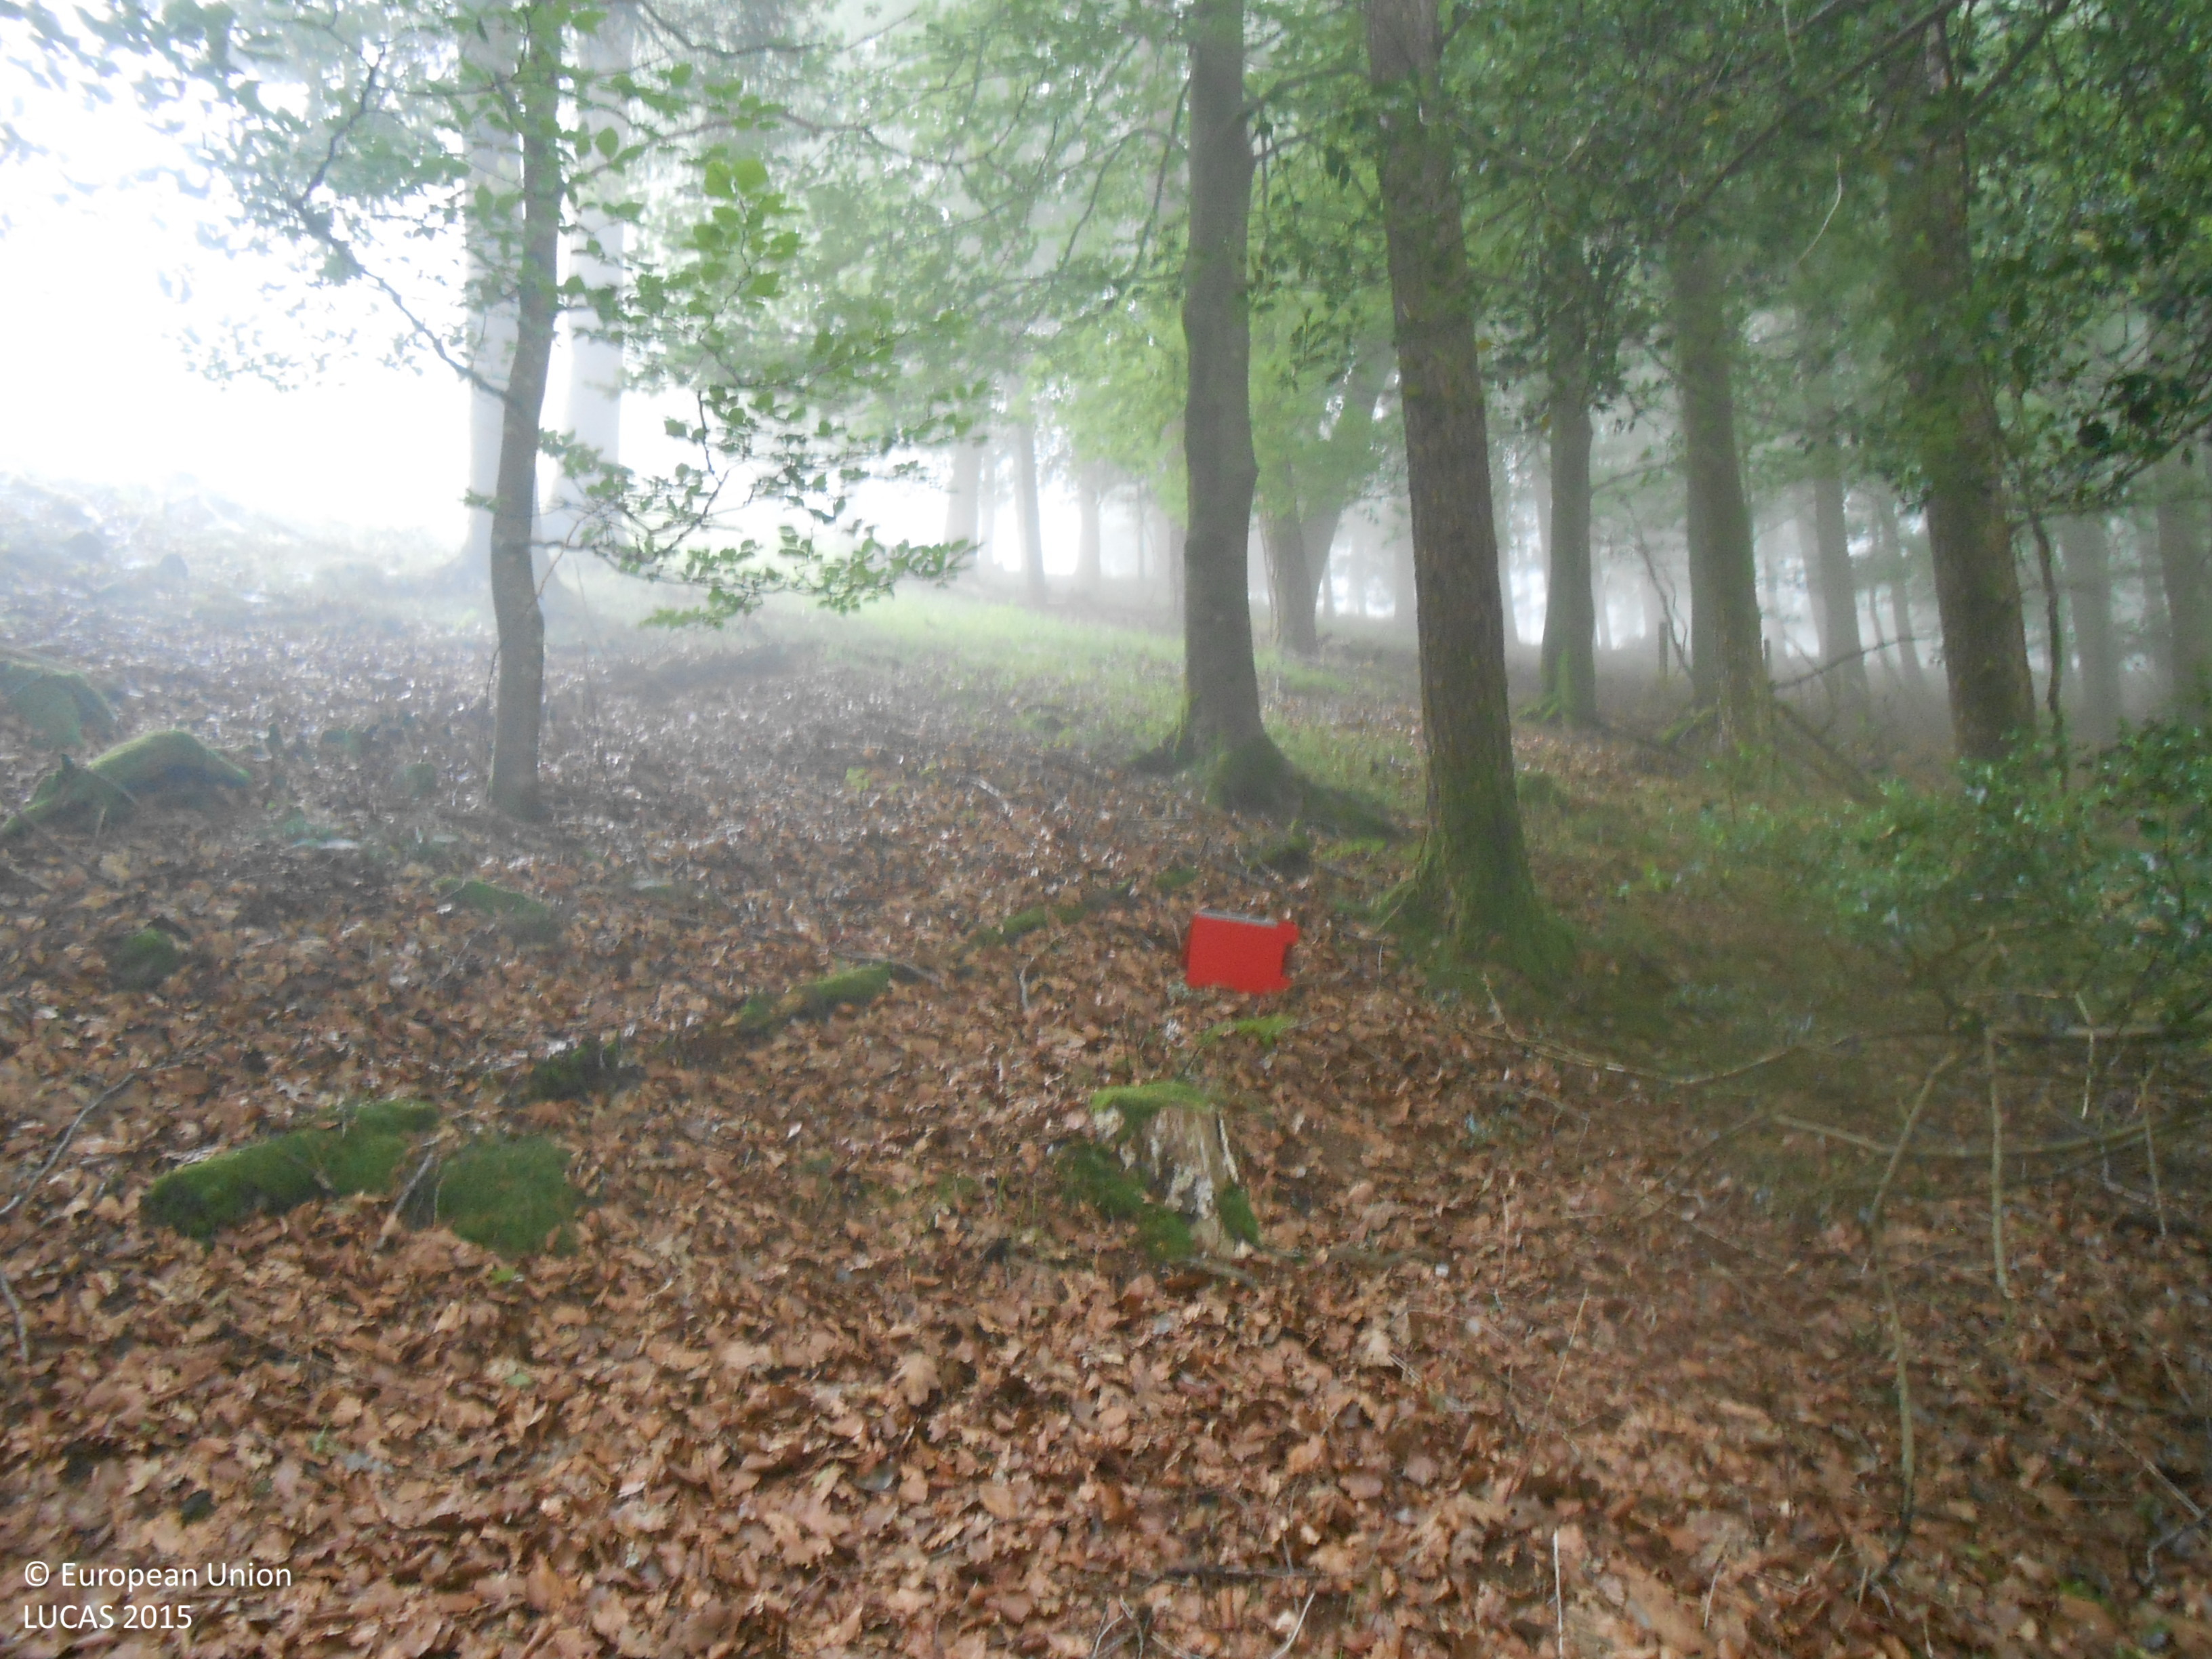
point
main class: Woodland
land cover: Broadleaved woodland
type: beech forest
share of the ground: > 75 %
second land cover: Grassland without tree/shrub cover
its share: > 75 %
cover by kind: broadleaved forest trees 100 %
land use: Forestry
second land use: Agriculture (excluding fallow land and kitchen gardens)
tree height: > 5 m
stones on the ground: < 10 %
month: June
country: ES
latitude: 43.2371
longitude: -1.8045
